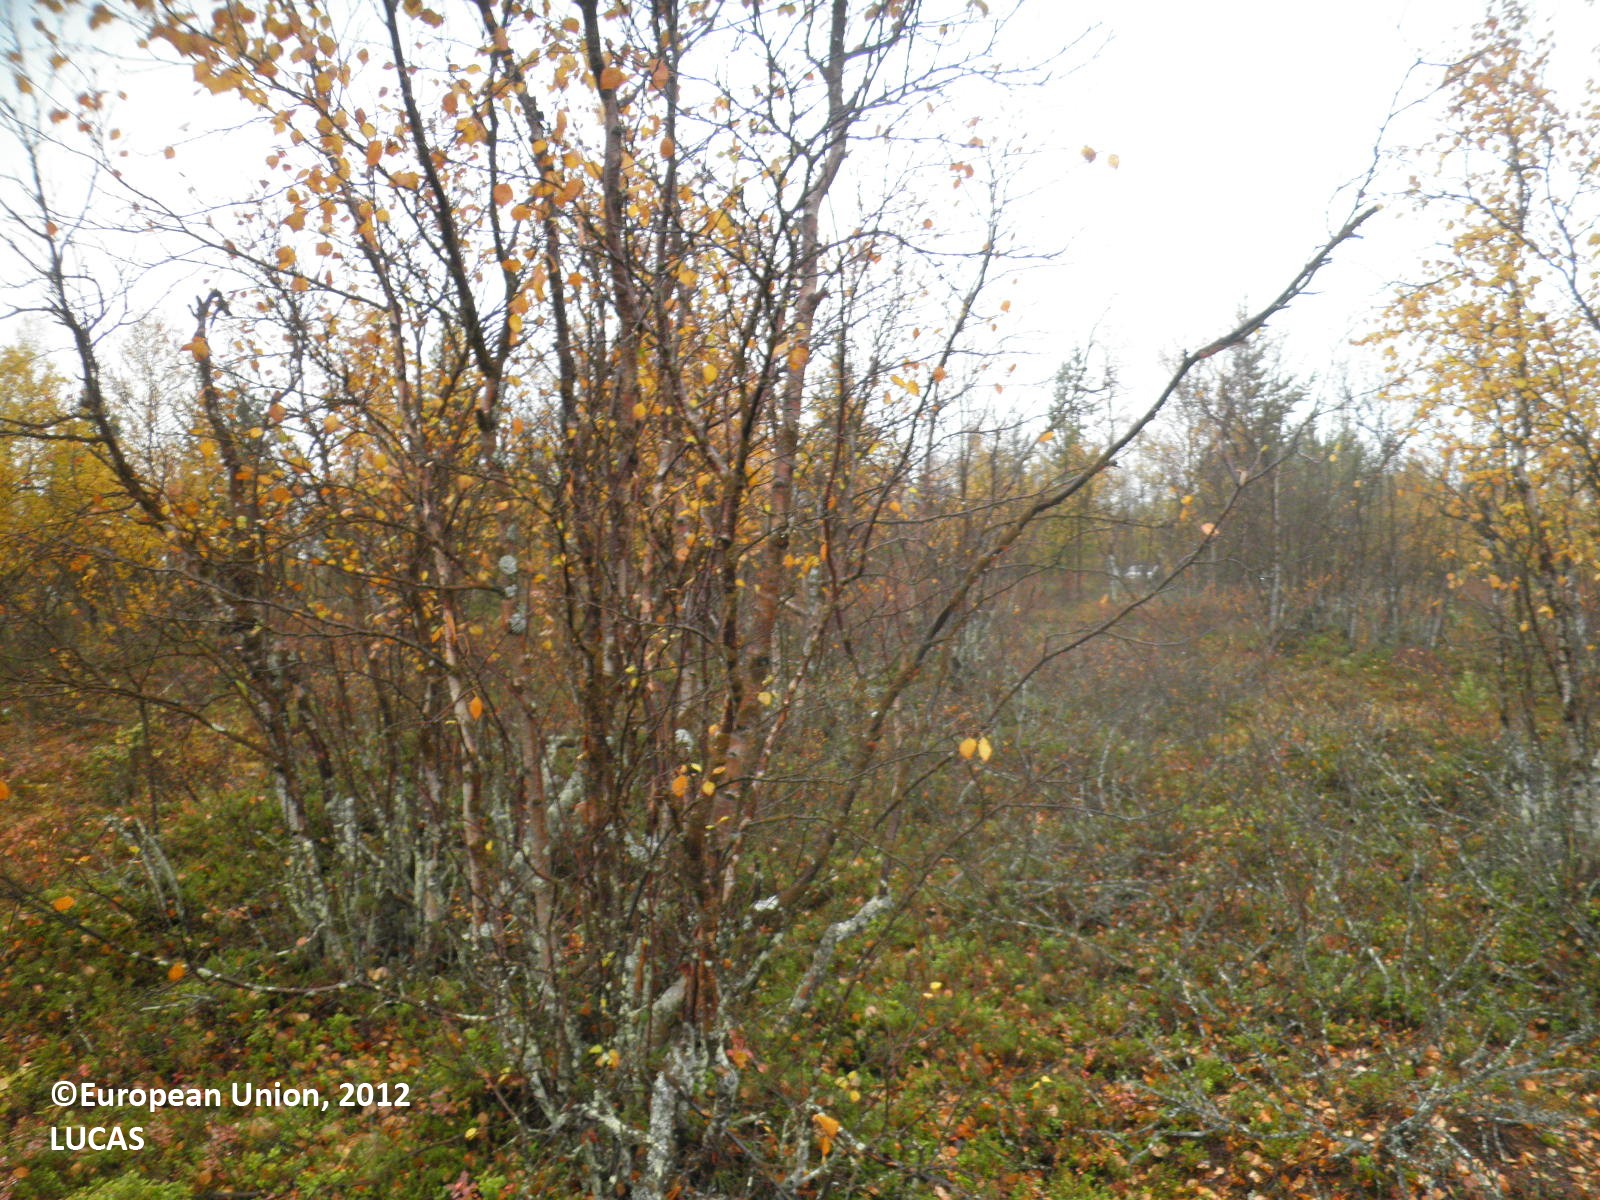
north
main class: Woodland
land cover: Broadleaved woodland
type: boreal forest
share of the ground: 50 - 75 %
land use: Forestry
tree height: > 5 m
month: September
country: FI
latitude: 68.4454
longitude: 22.7017
